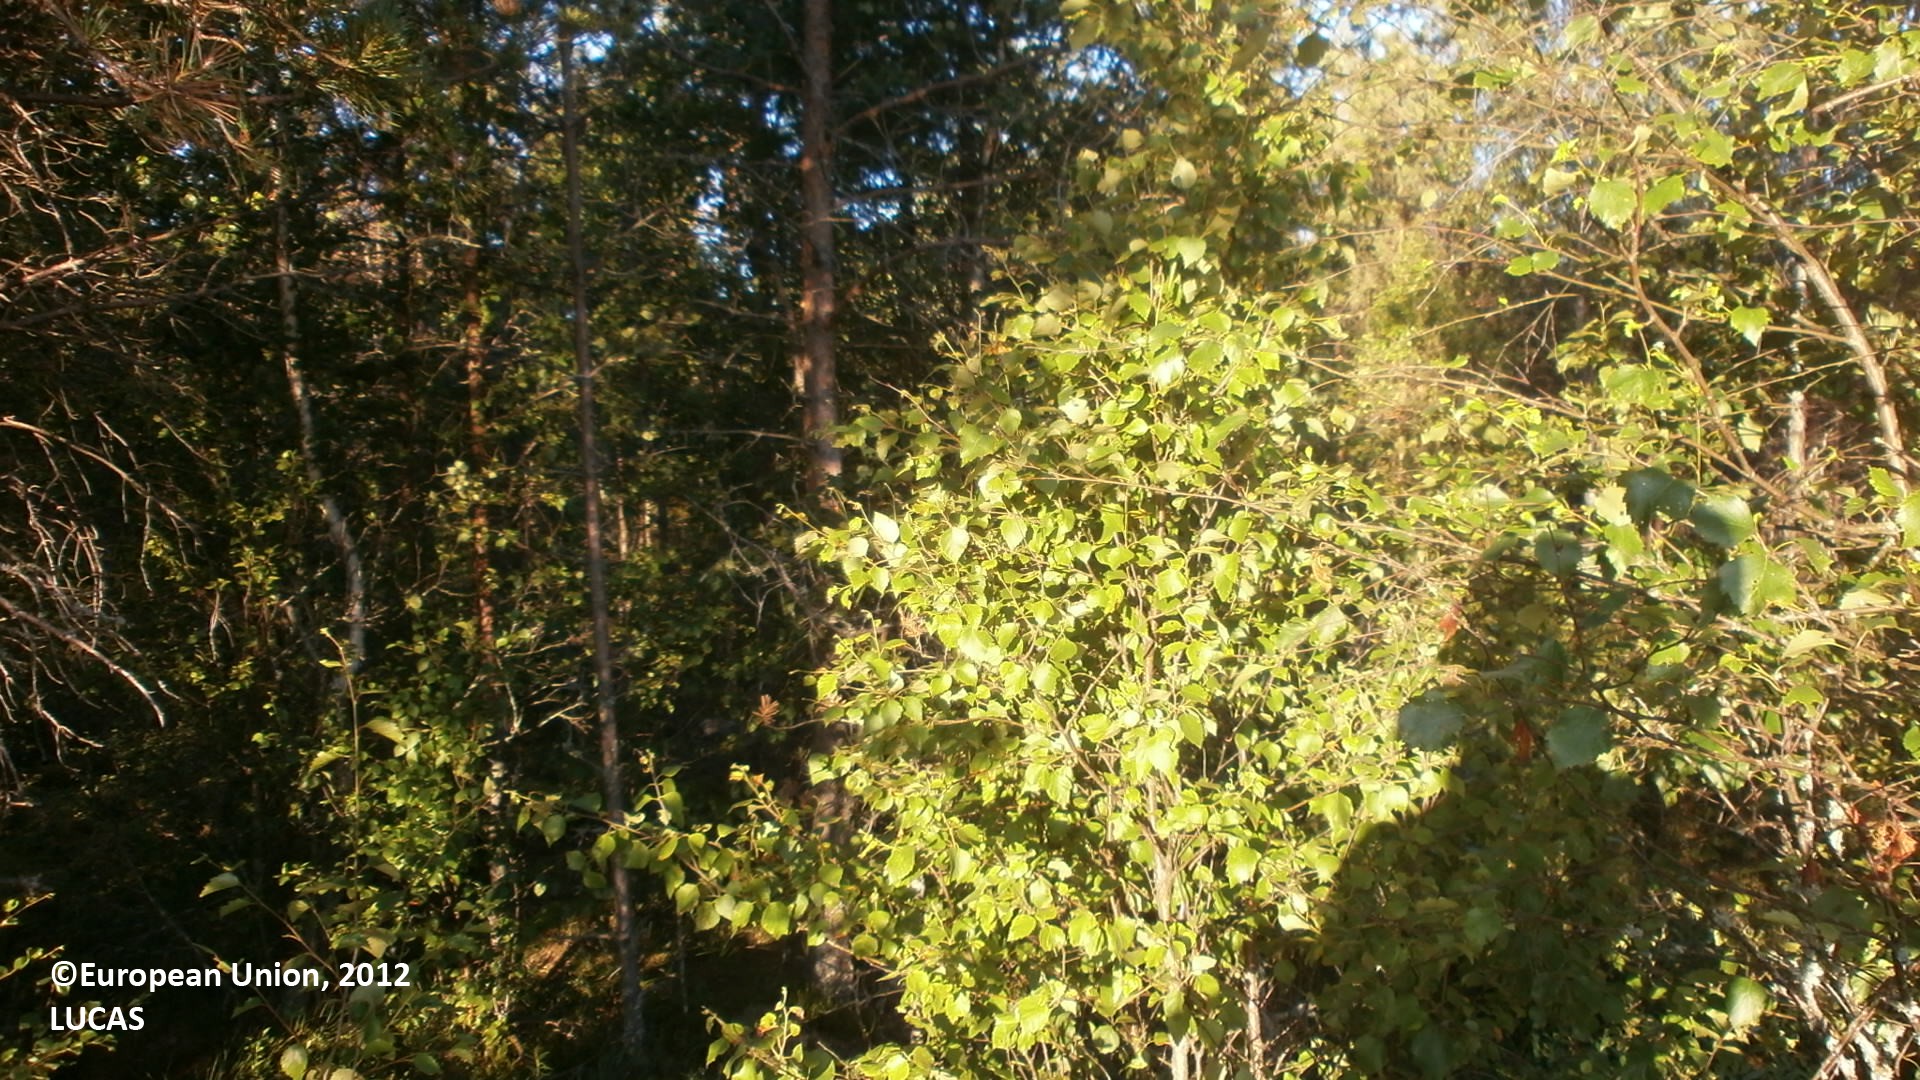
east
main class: Woodland
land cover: Pine dominated mixed woodland
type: boreal forest
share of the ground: 50 - 75 %
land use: Forestry
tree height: > 5 m
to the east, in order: Pine dominated mixed woodland; Ditches and canals; Pine dominated mixed woodland; Pine dominated coniferous woodland
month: July
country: FI
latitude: 64.0412
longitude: 24.0927
